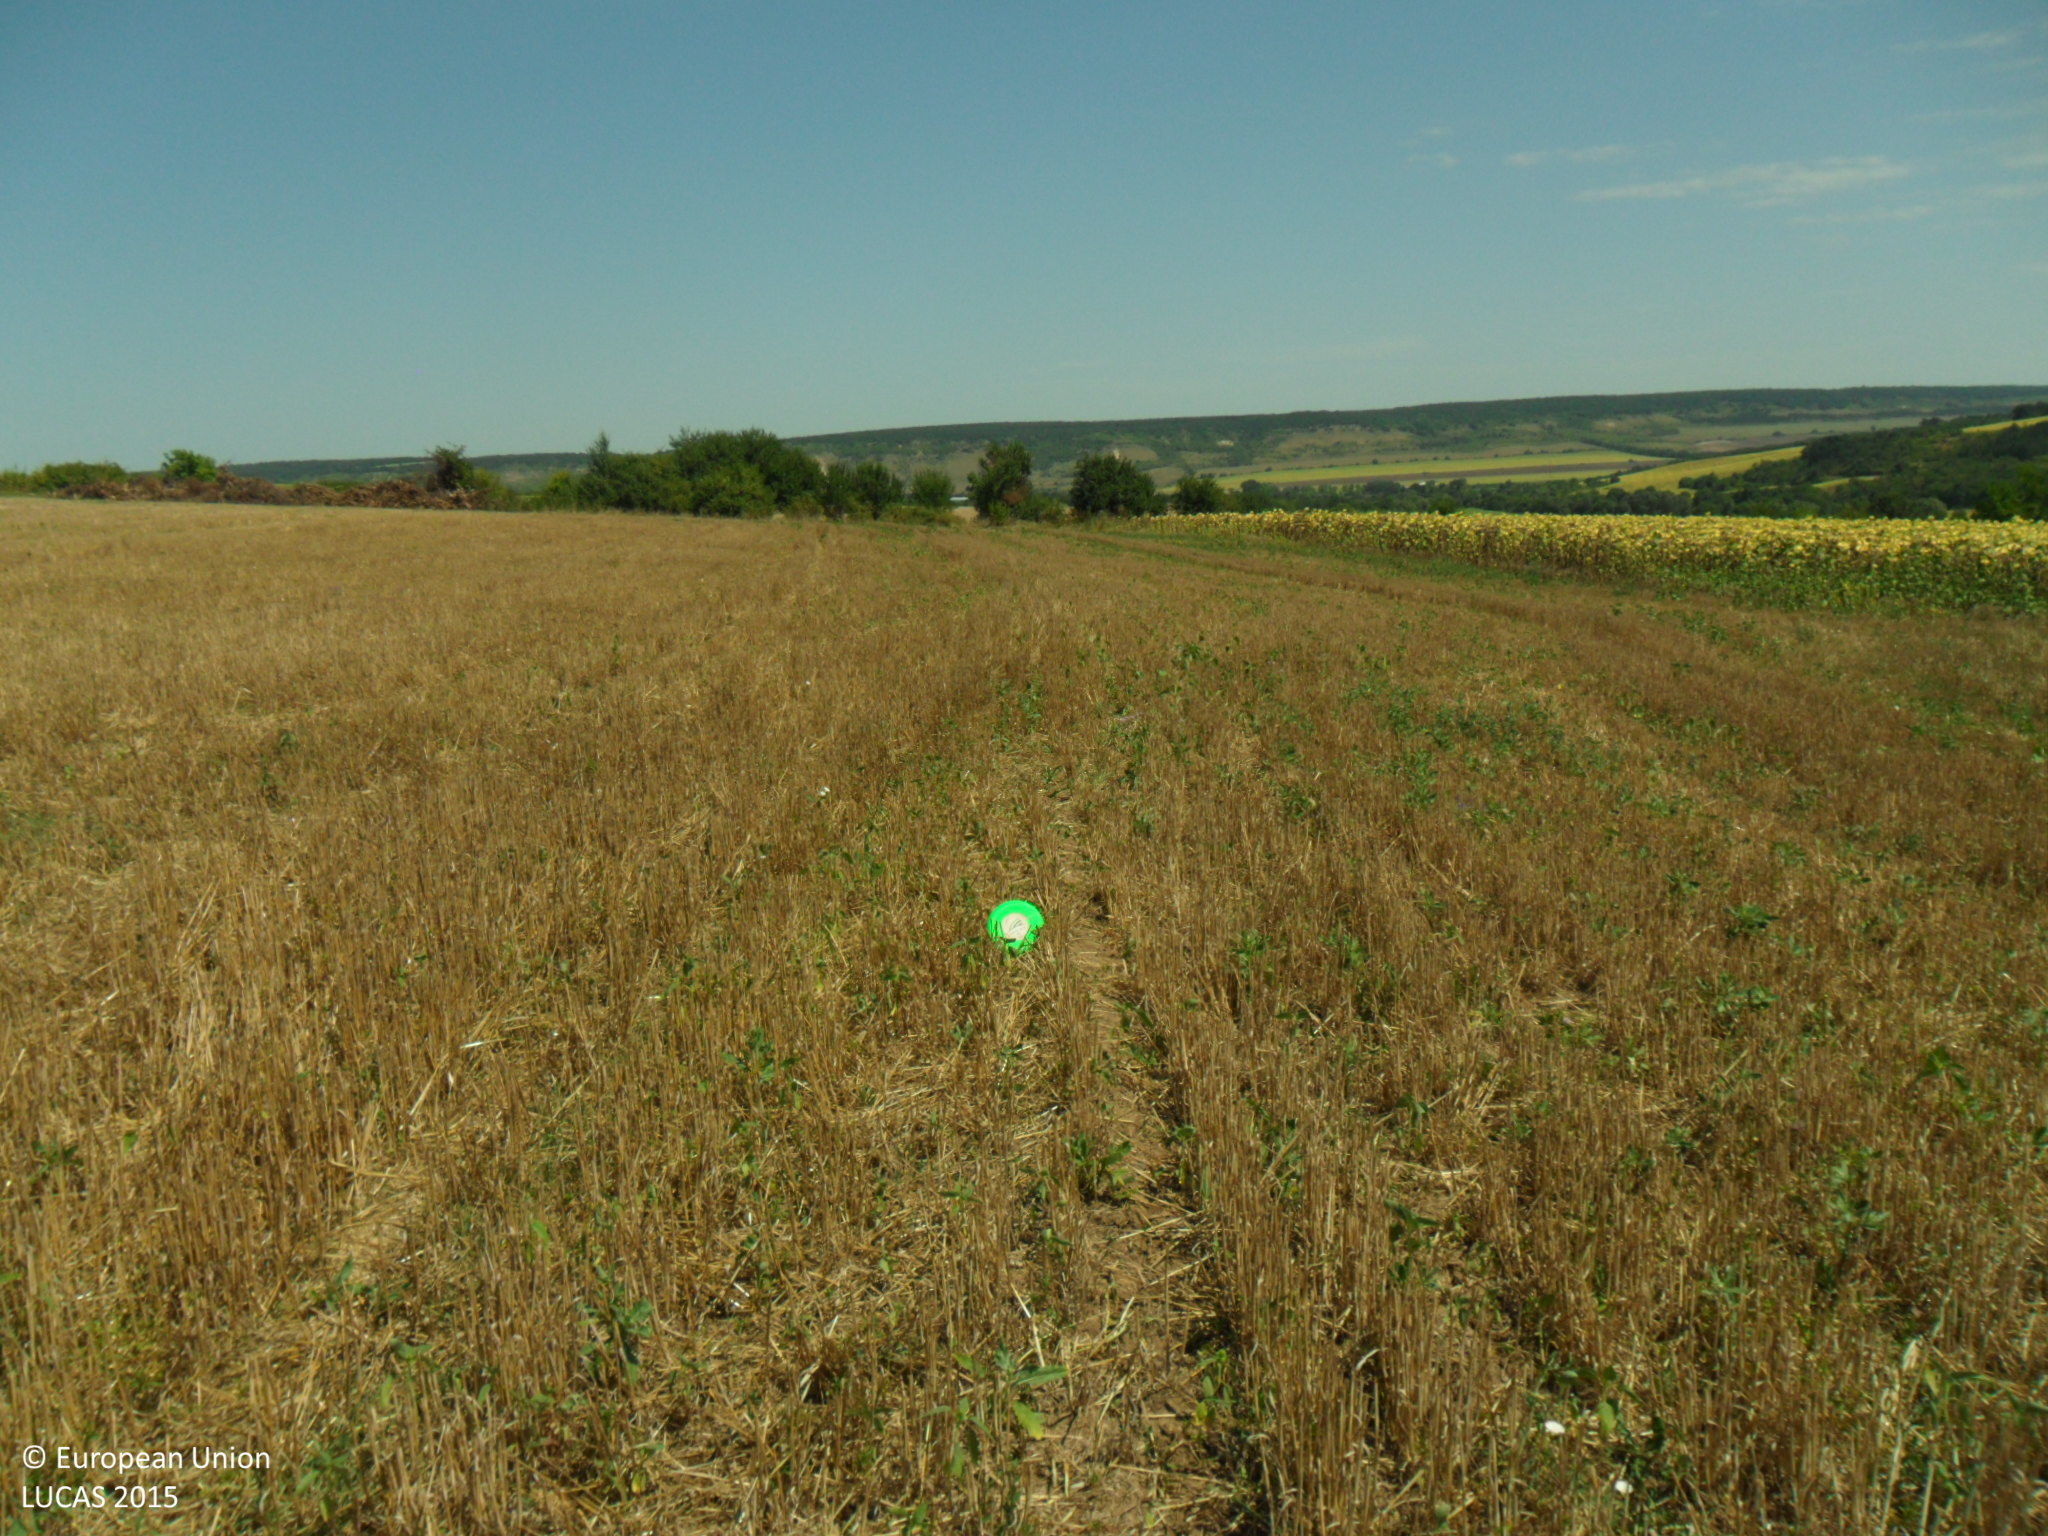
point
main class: Cropland
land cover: Common wheat
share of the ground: 25 - 50 %
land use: Agriculture (excluding fallow land and kitchen gardens)
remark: Harvested field
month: August
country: BG
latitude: 43.5489
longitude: 26.4040
